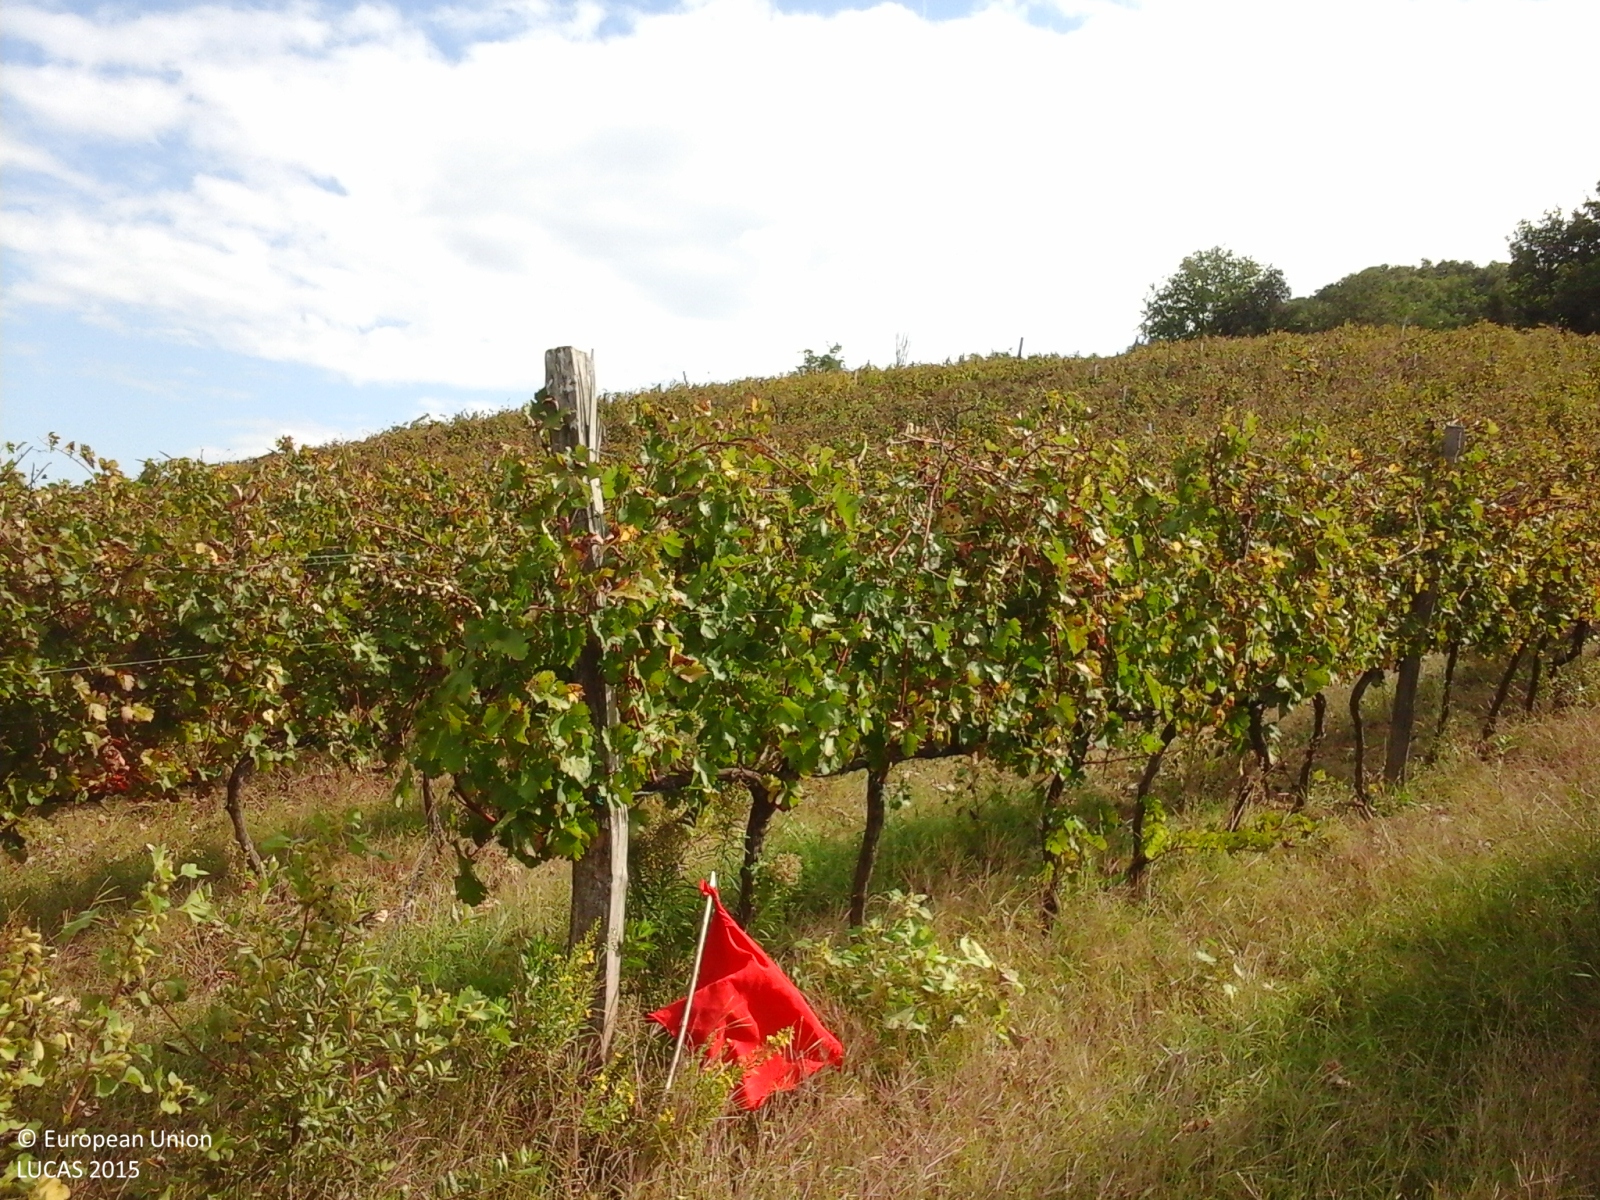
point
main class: Cropland
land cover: Vineyards
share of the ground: > 75 %
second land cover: Grassland without tree/shrub cover
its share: > 75 %
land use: Agriculture (excluding fallow land and kitchen gardens)
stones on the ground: < 10 %
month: August
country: IT
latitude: 43.3384
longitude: 10.6026
